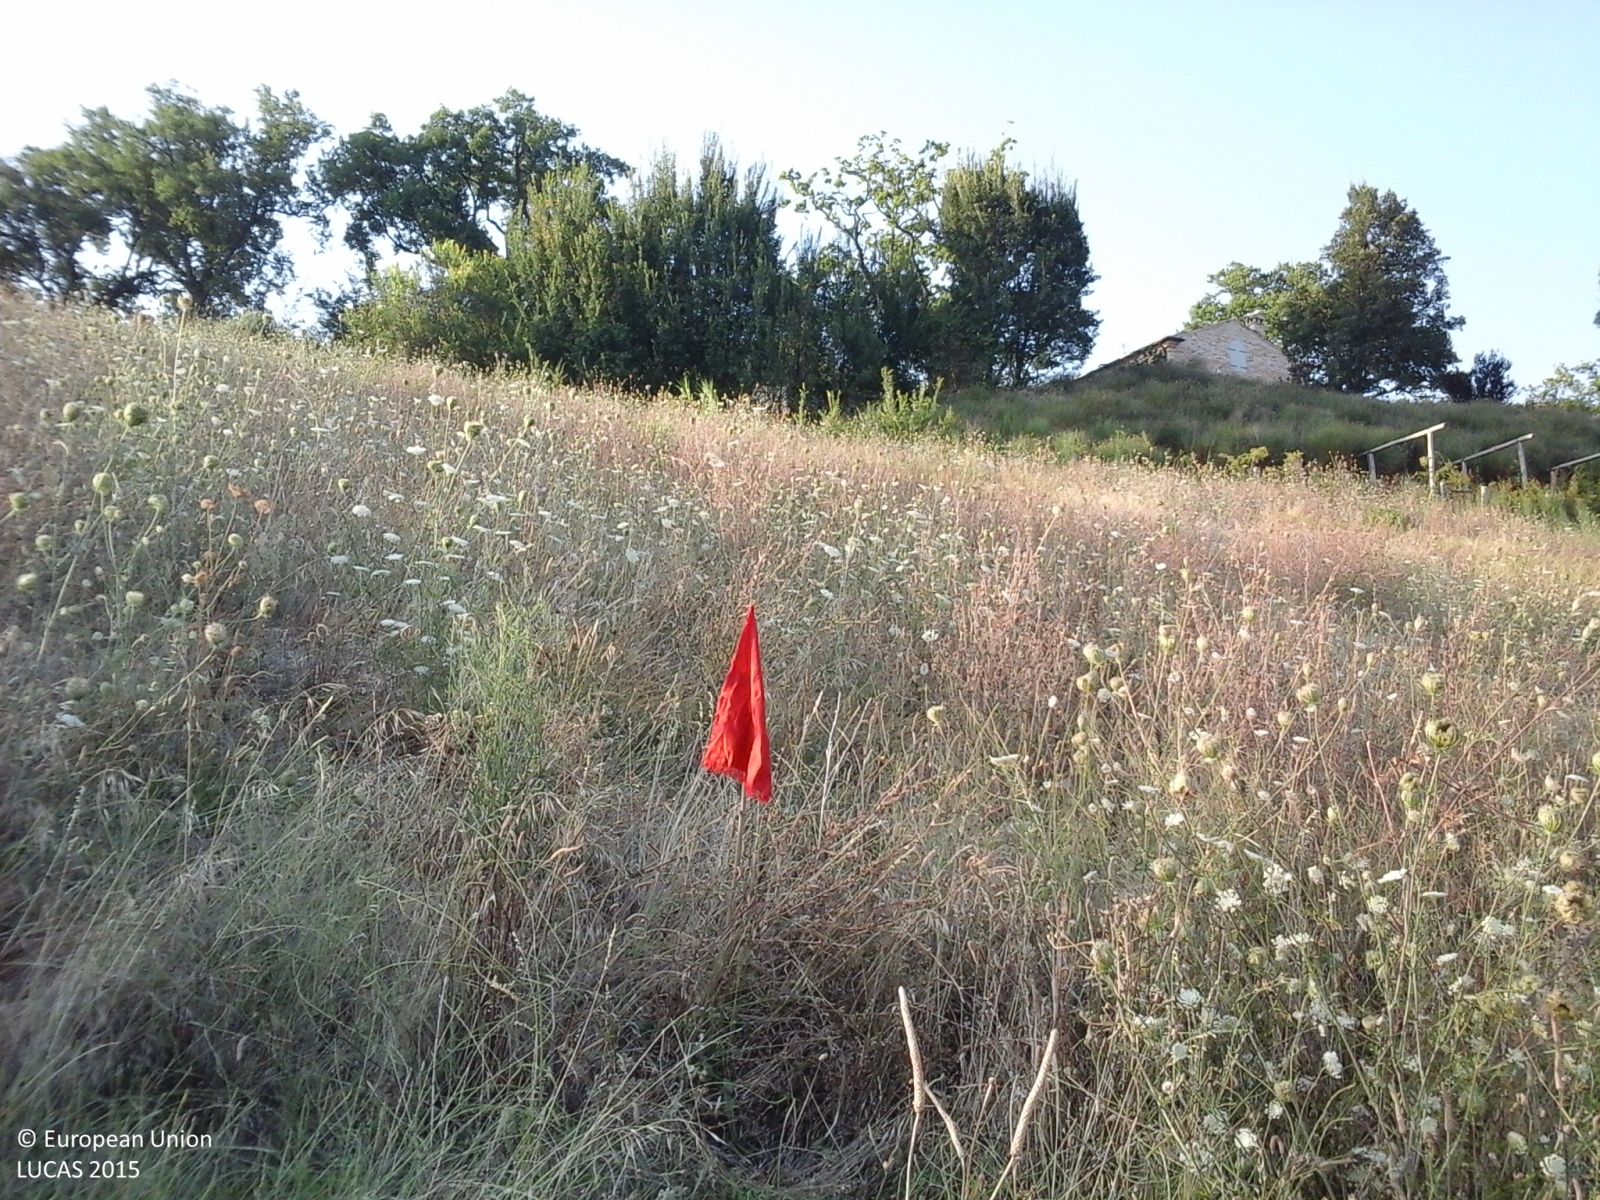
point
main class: Grassland
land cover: Spontaneously vegetated surfaces
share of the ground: > 75 %
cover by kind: herbaceous plants 100 %
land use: Fallow land
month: August
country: IT
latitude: 43.1548
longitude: 13.4710
